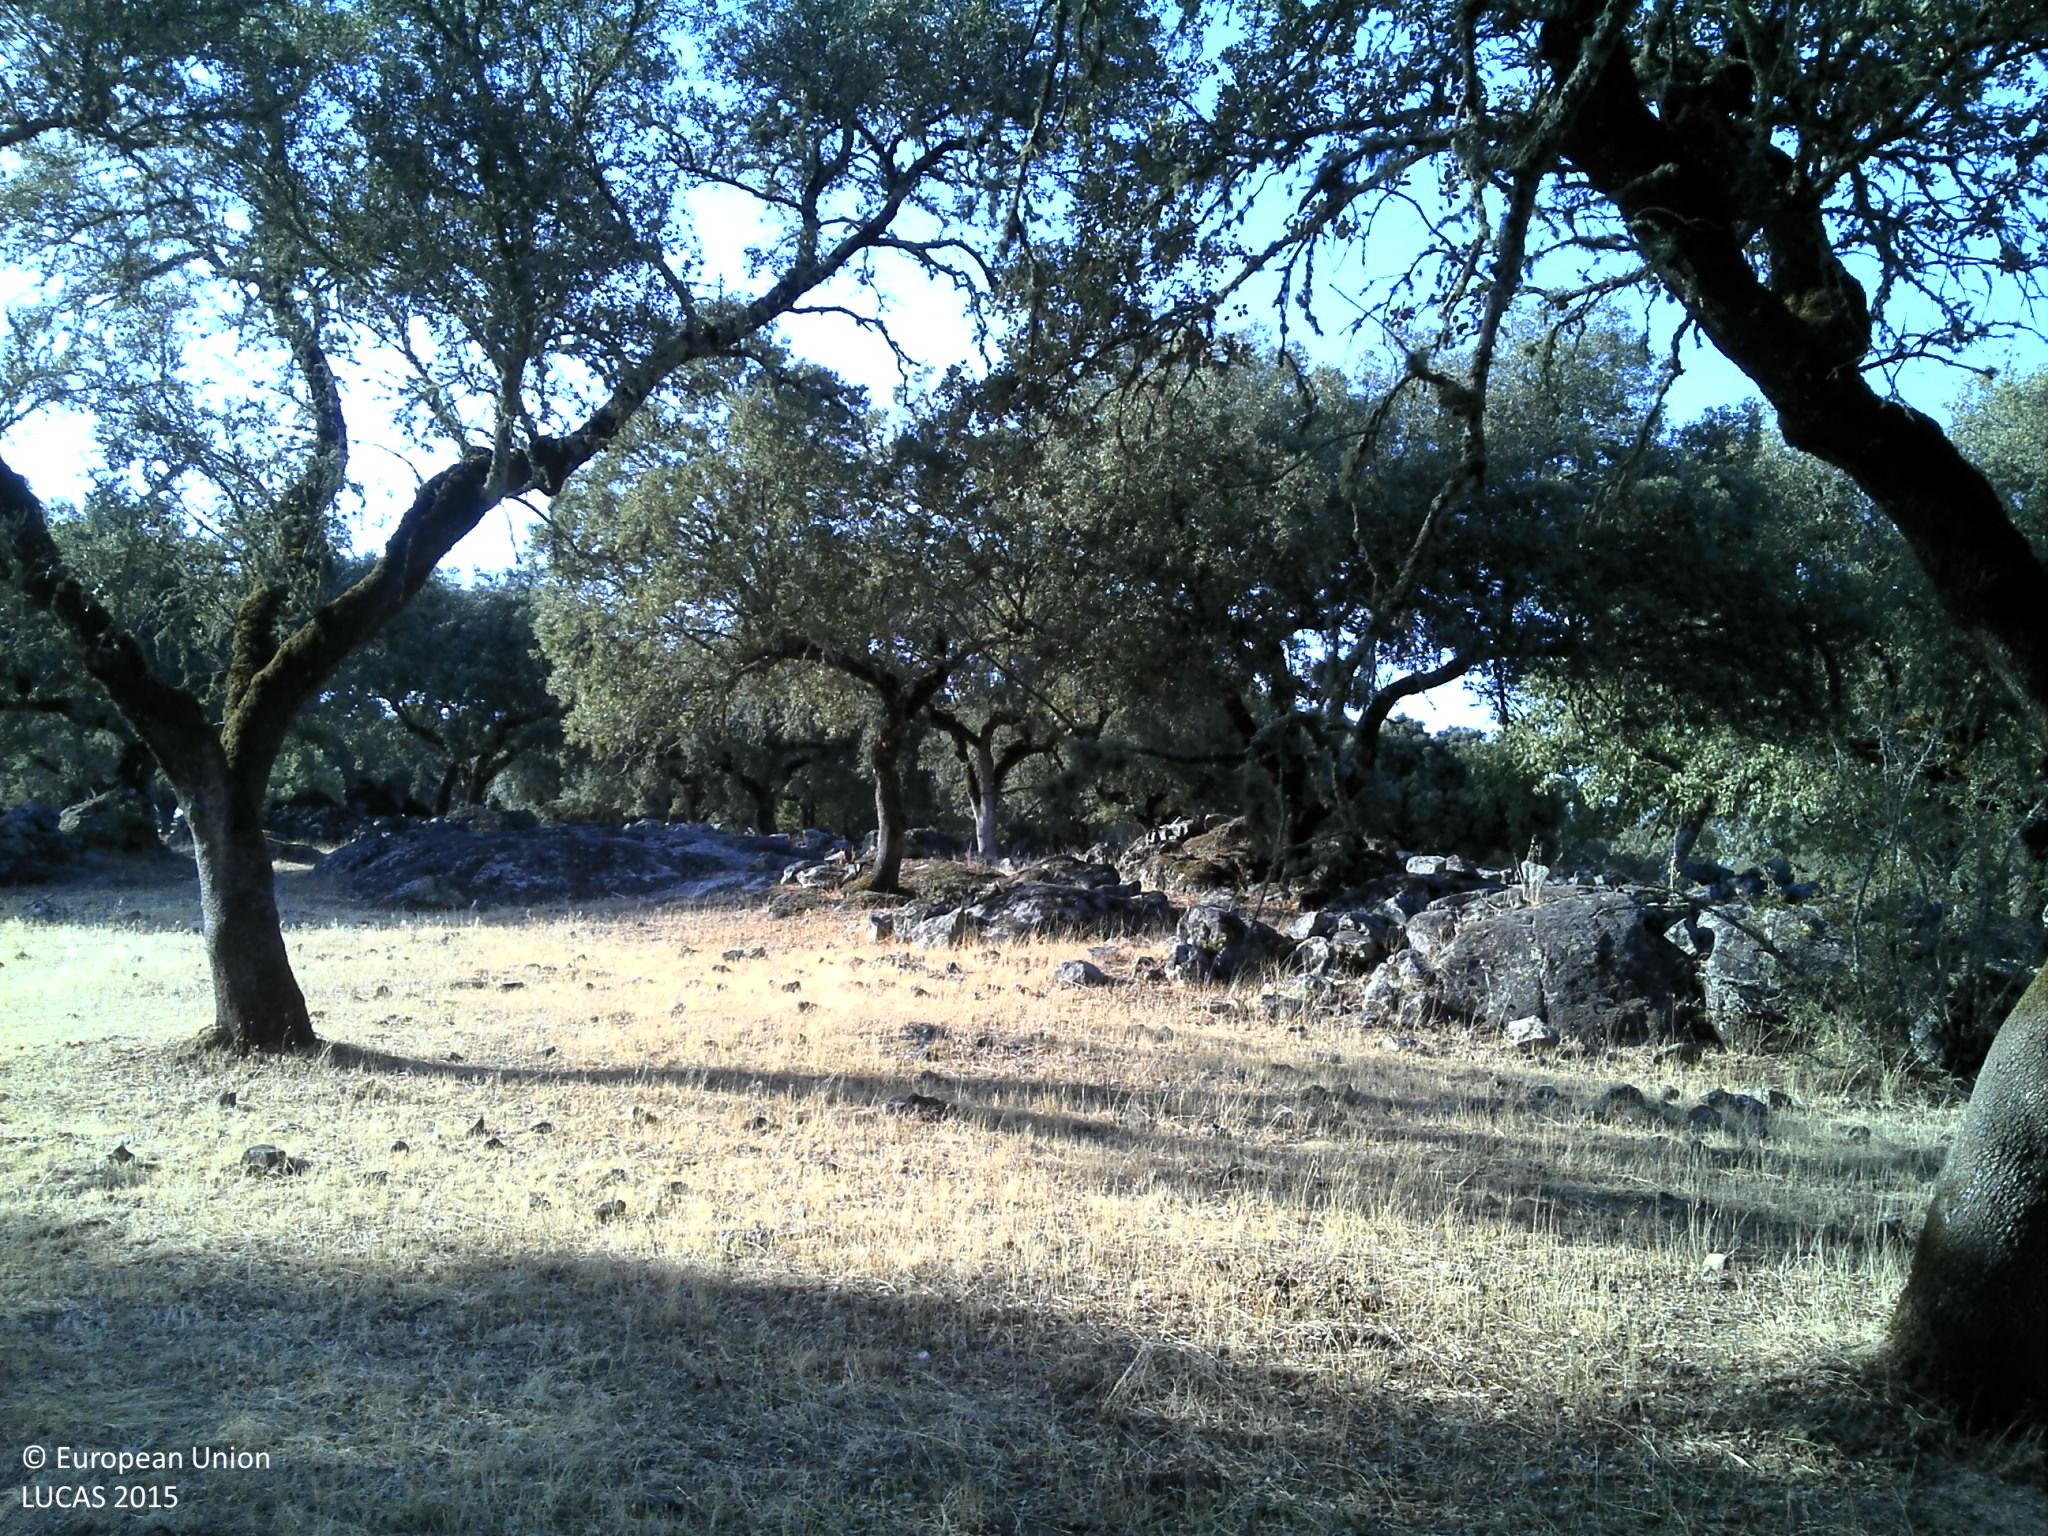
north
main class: Woodland
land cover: Broadleaved woodland
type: broadleaved evergreen forest
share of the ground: 25 - 50 %
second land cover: Grassland without tree/shrub cover
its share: 10 - 25 %
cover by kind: unconsolidated bare surface 55 %, broadleaved forest trees 30 %, herbaceous plants 15 %
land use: Forestry
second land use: Agriculture (excluding fallow land and kitchen gardens)
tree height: > 5 m
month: August
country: PT
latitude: 39.3181
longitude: -7.5473
